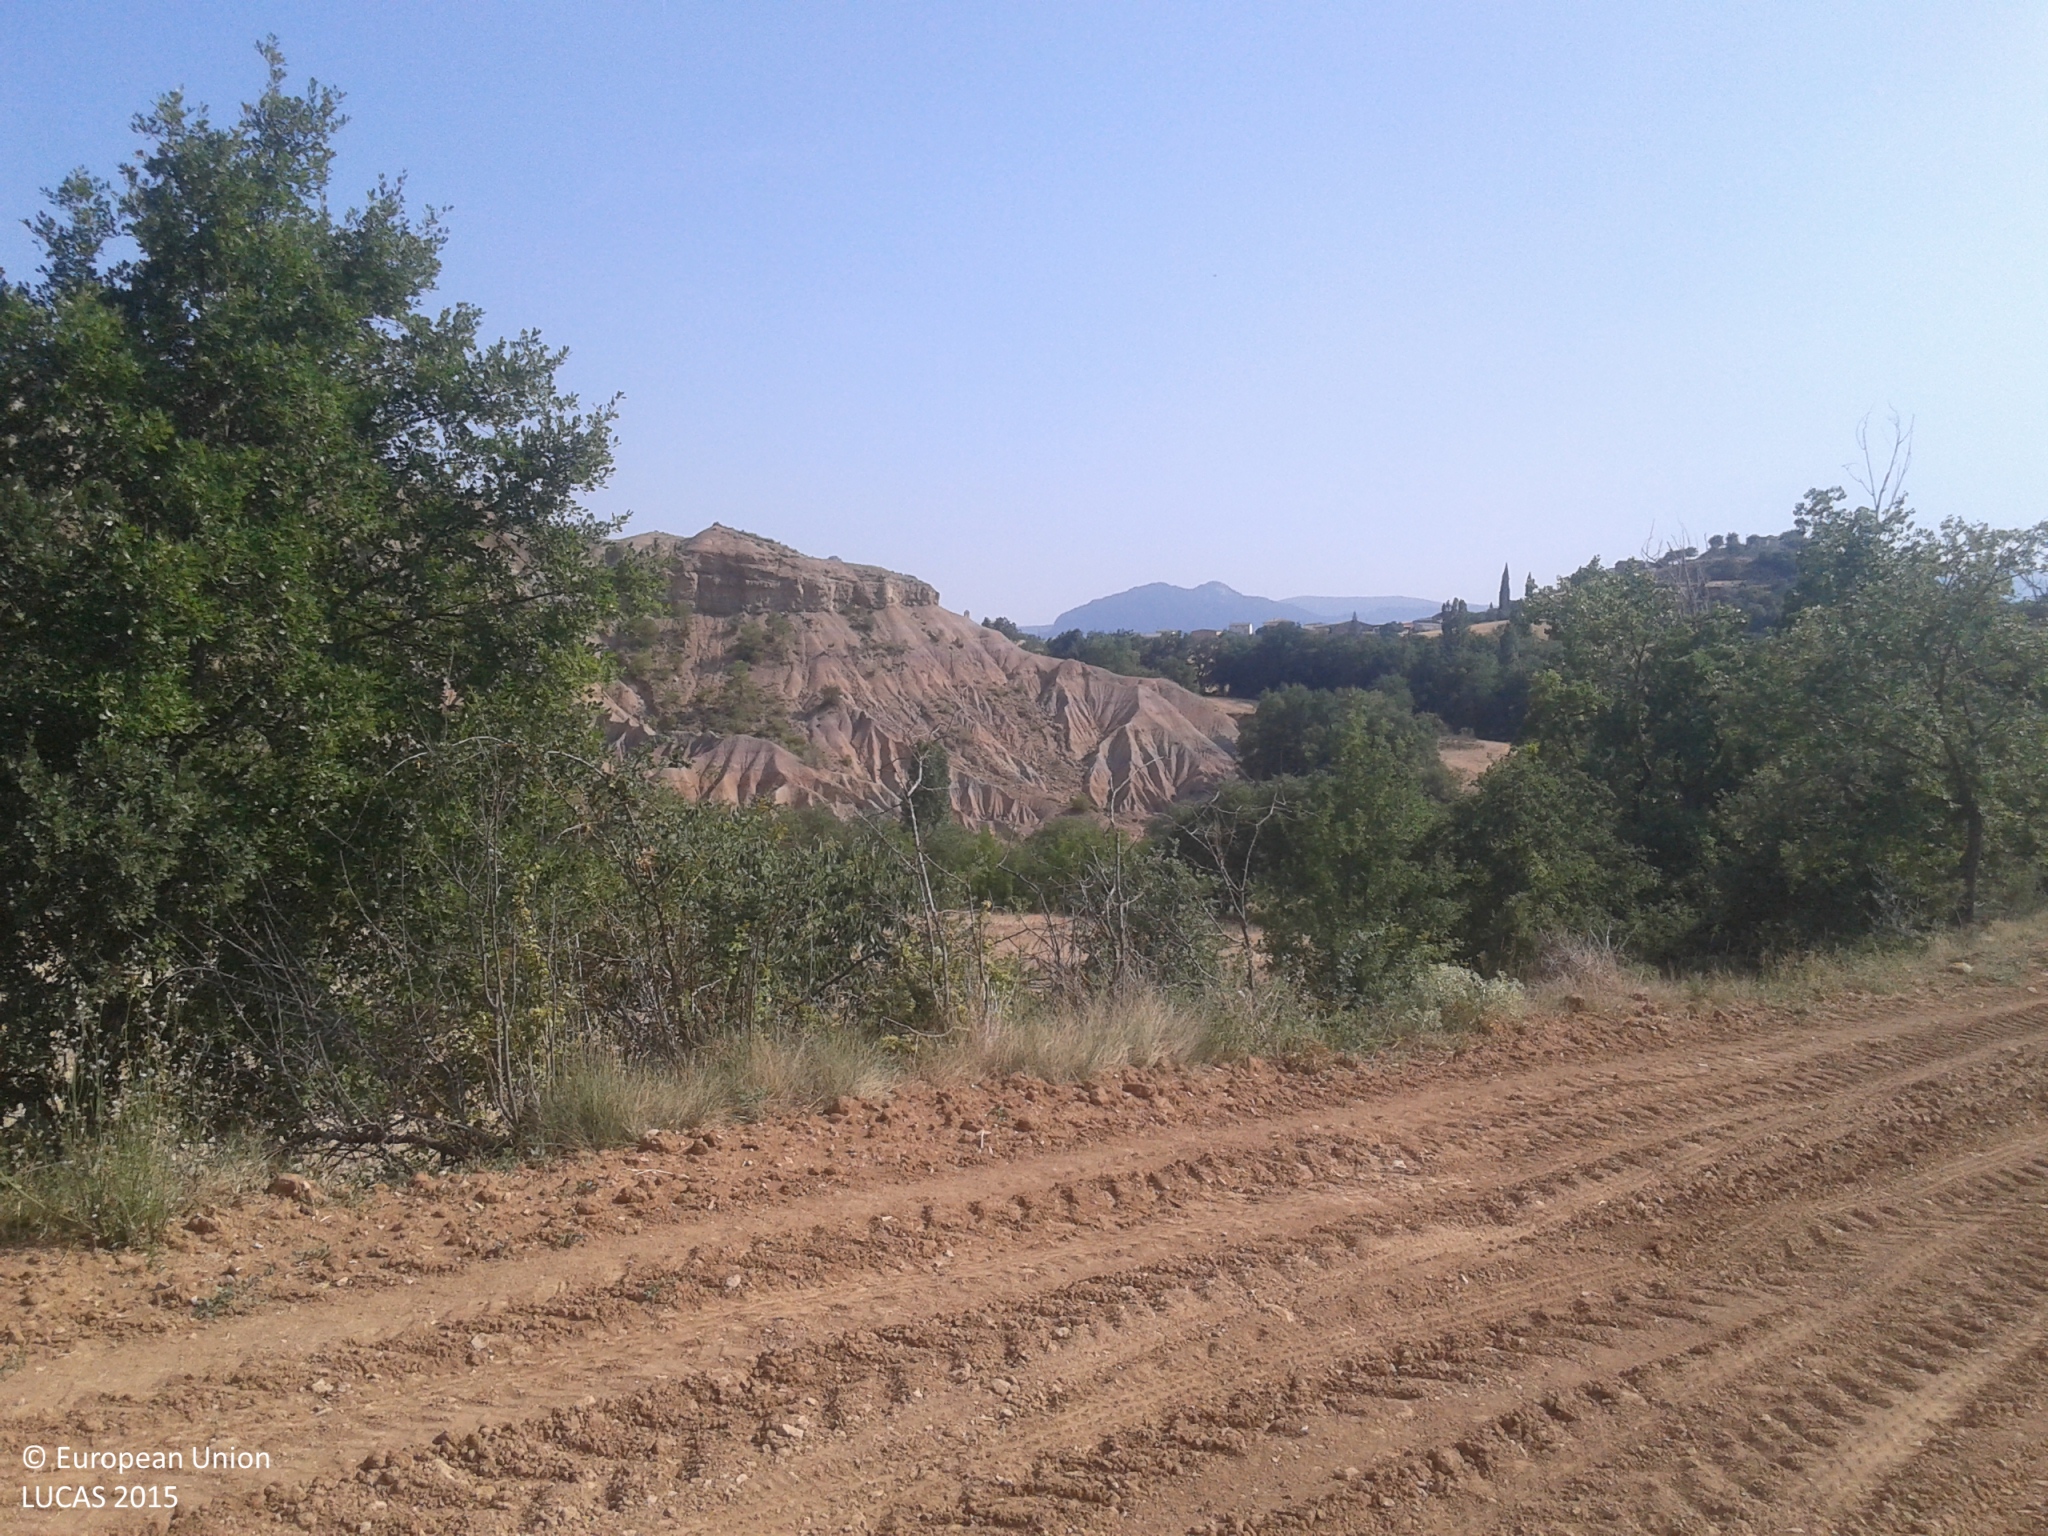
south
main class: Cropland
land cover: Nuts trees
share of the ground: < 10 %
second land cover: Other bare soil
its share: > 75 %
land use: Agriculture (excluding fallow land and kitchen gardens)
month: July
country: ES
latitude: 42.1475
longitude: 1.0431
